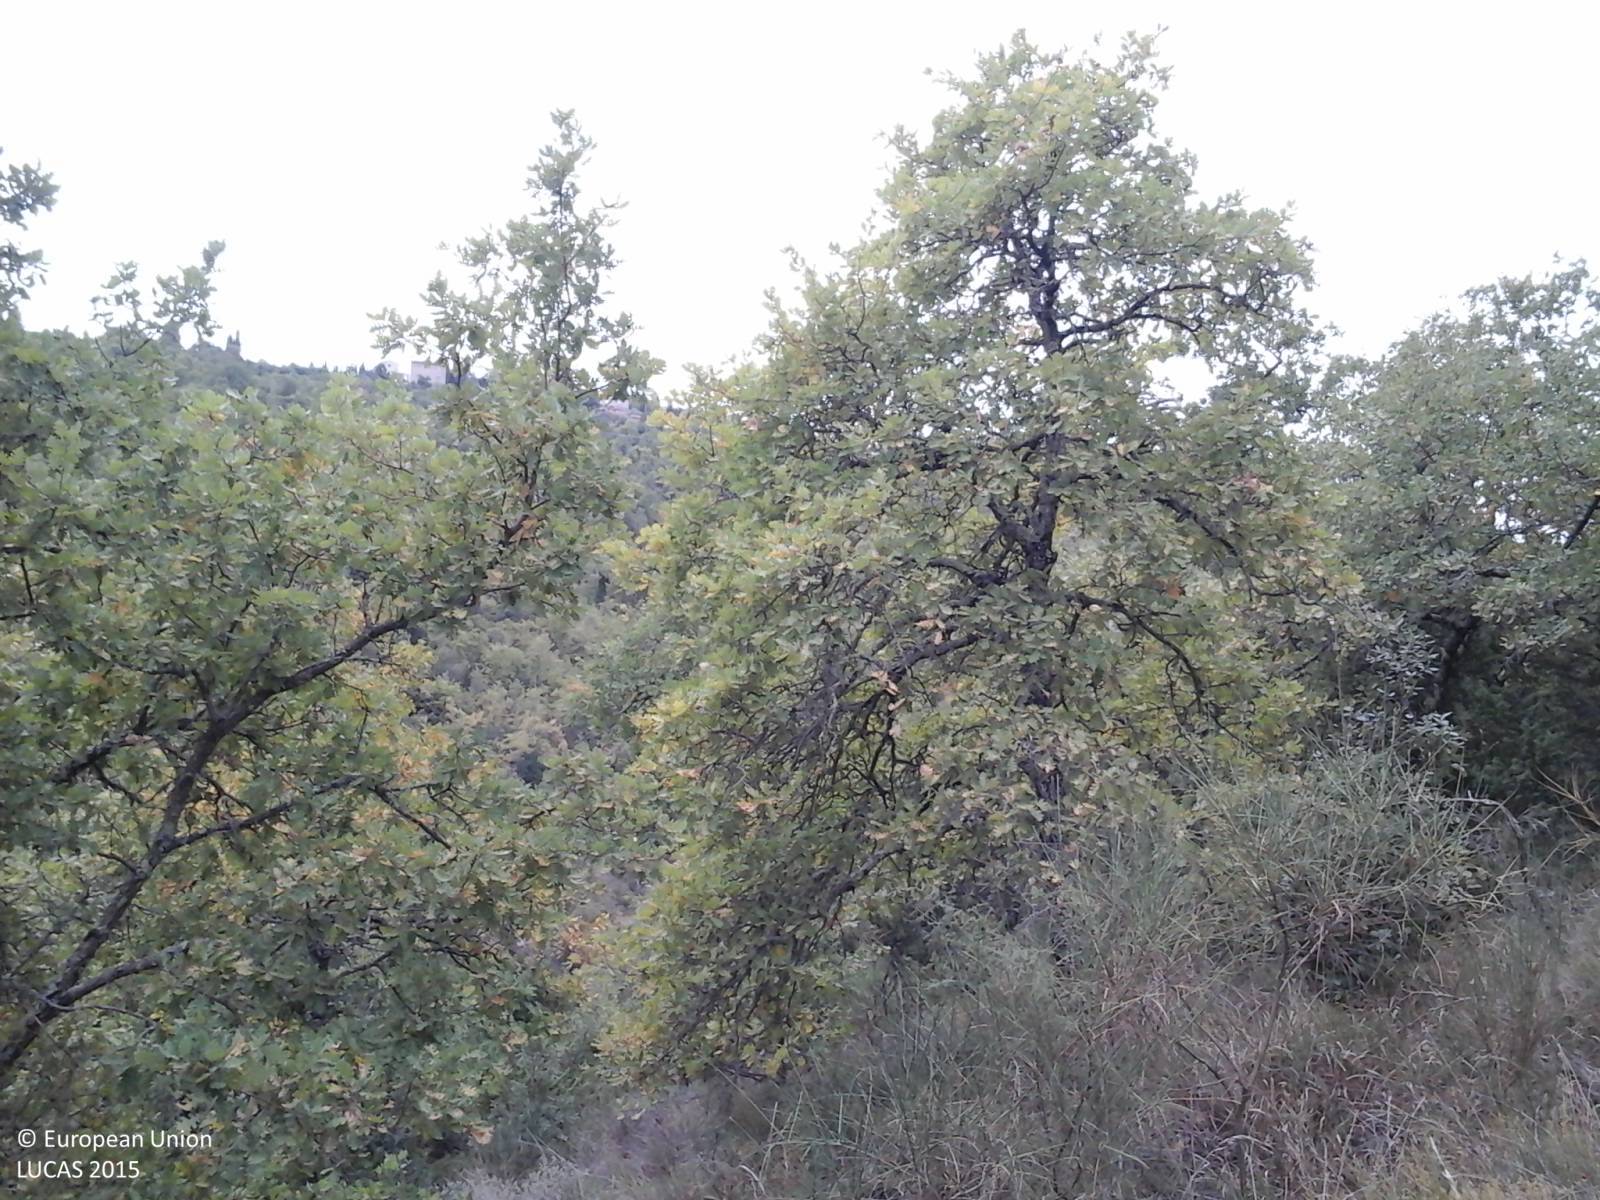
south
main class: Woodland
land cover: Broadleaved woodland
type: thermophilous deciduous forest
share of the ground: > 75 %
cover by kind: broadleaved forest trees 100 %
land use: Forestry
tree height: > 5 m
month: September
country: IT
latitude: 42.9365
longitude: 12.2357
